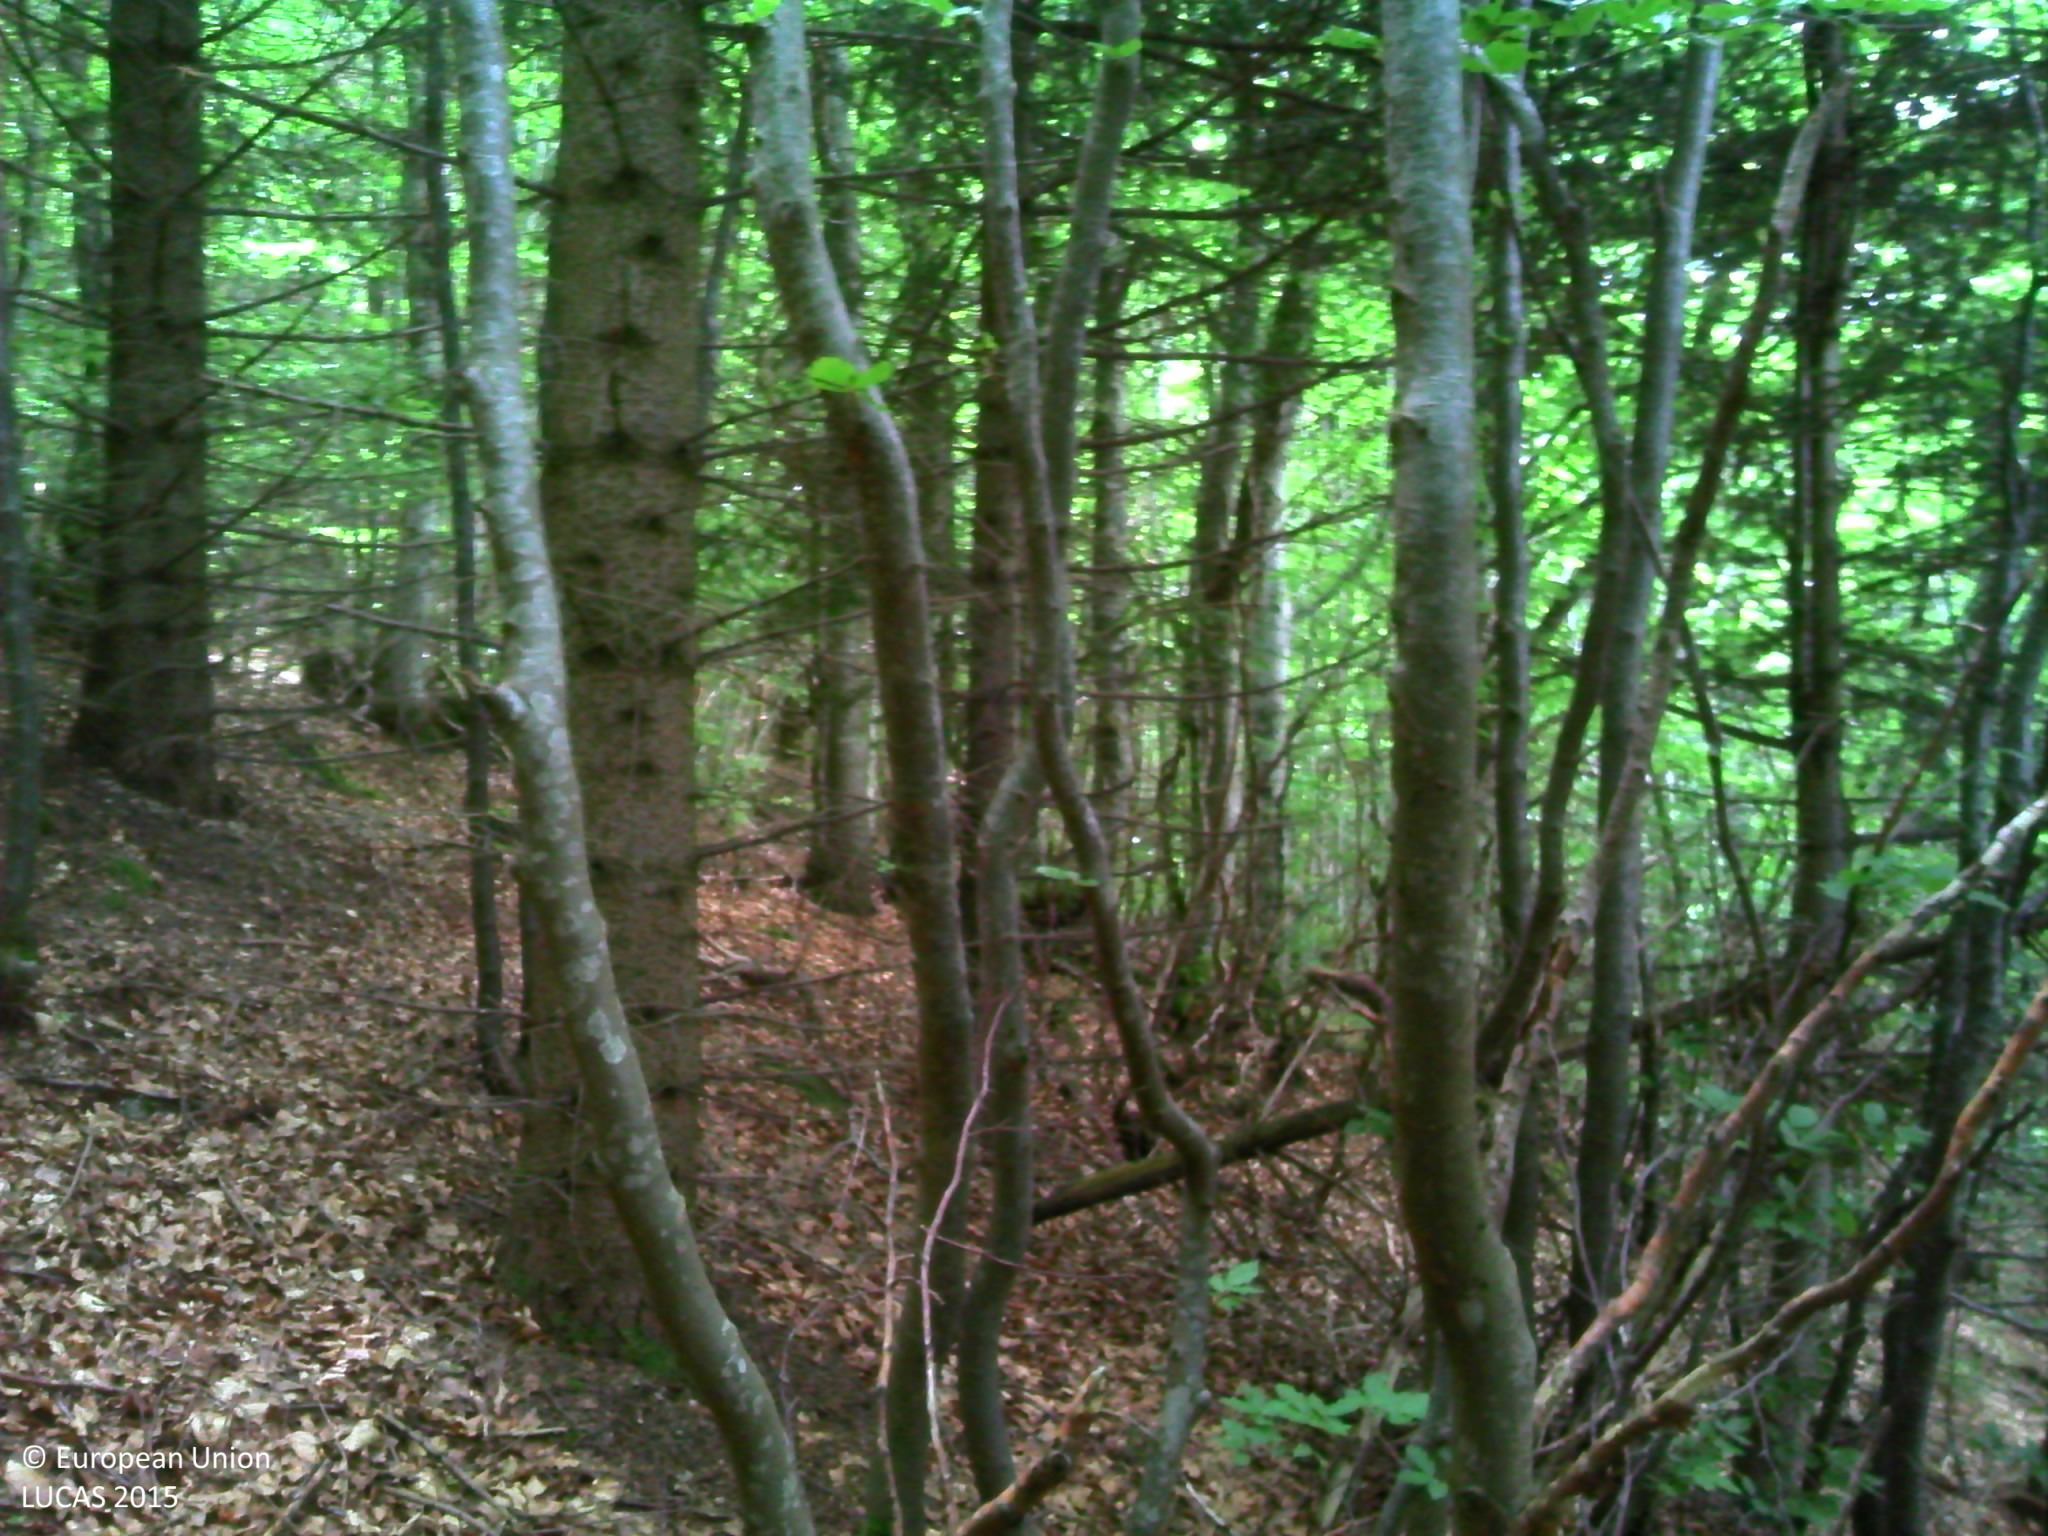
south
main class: Woodland
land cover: Other mixed woodland
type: mountainous beech forest
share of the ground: > 75 %
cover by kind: coniferous forest trees 65 %, broadleaved forest trees 35 %
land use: Forestry
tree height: > 5 m
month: June
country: FR
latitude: 44.6032
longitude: 3.8698
